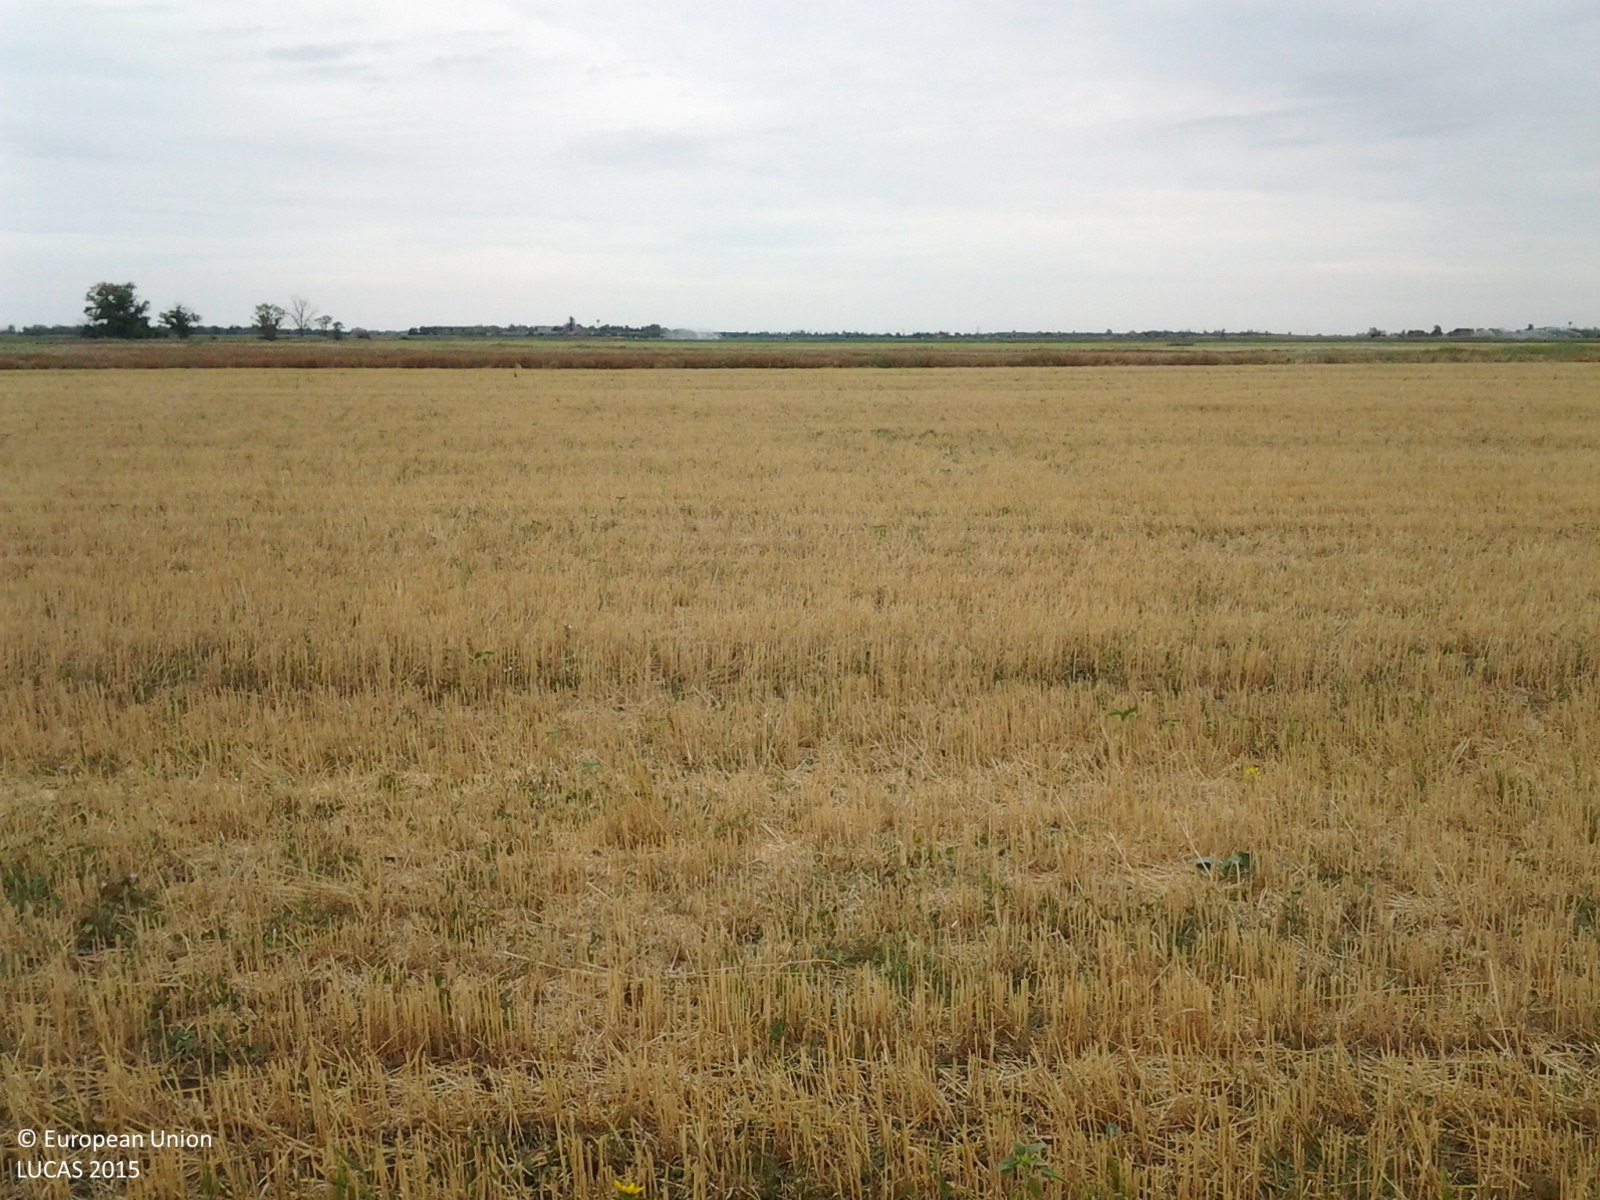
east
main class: Cropland
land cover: Common wheat
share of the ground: < 10 %
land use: Agriculture (excluding fallow land and kitchen gardens)
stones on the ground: < 10 %
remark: Harvested field
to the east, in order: Common wheat; Rape and turnip rape
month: July
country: HU
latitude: 47.2883
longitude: 20.8364
